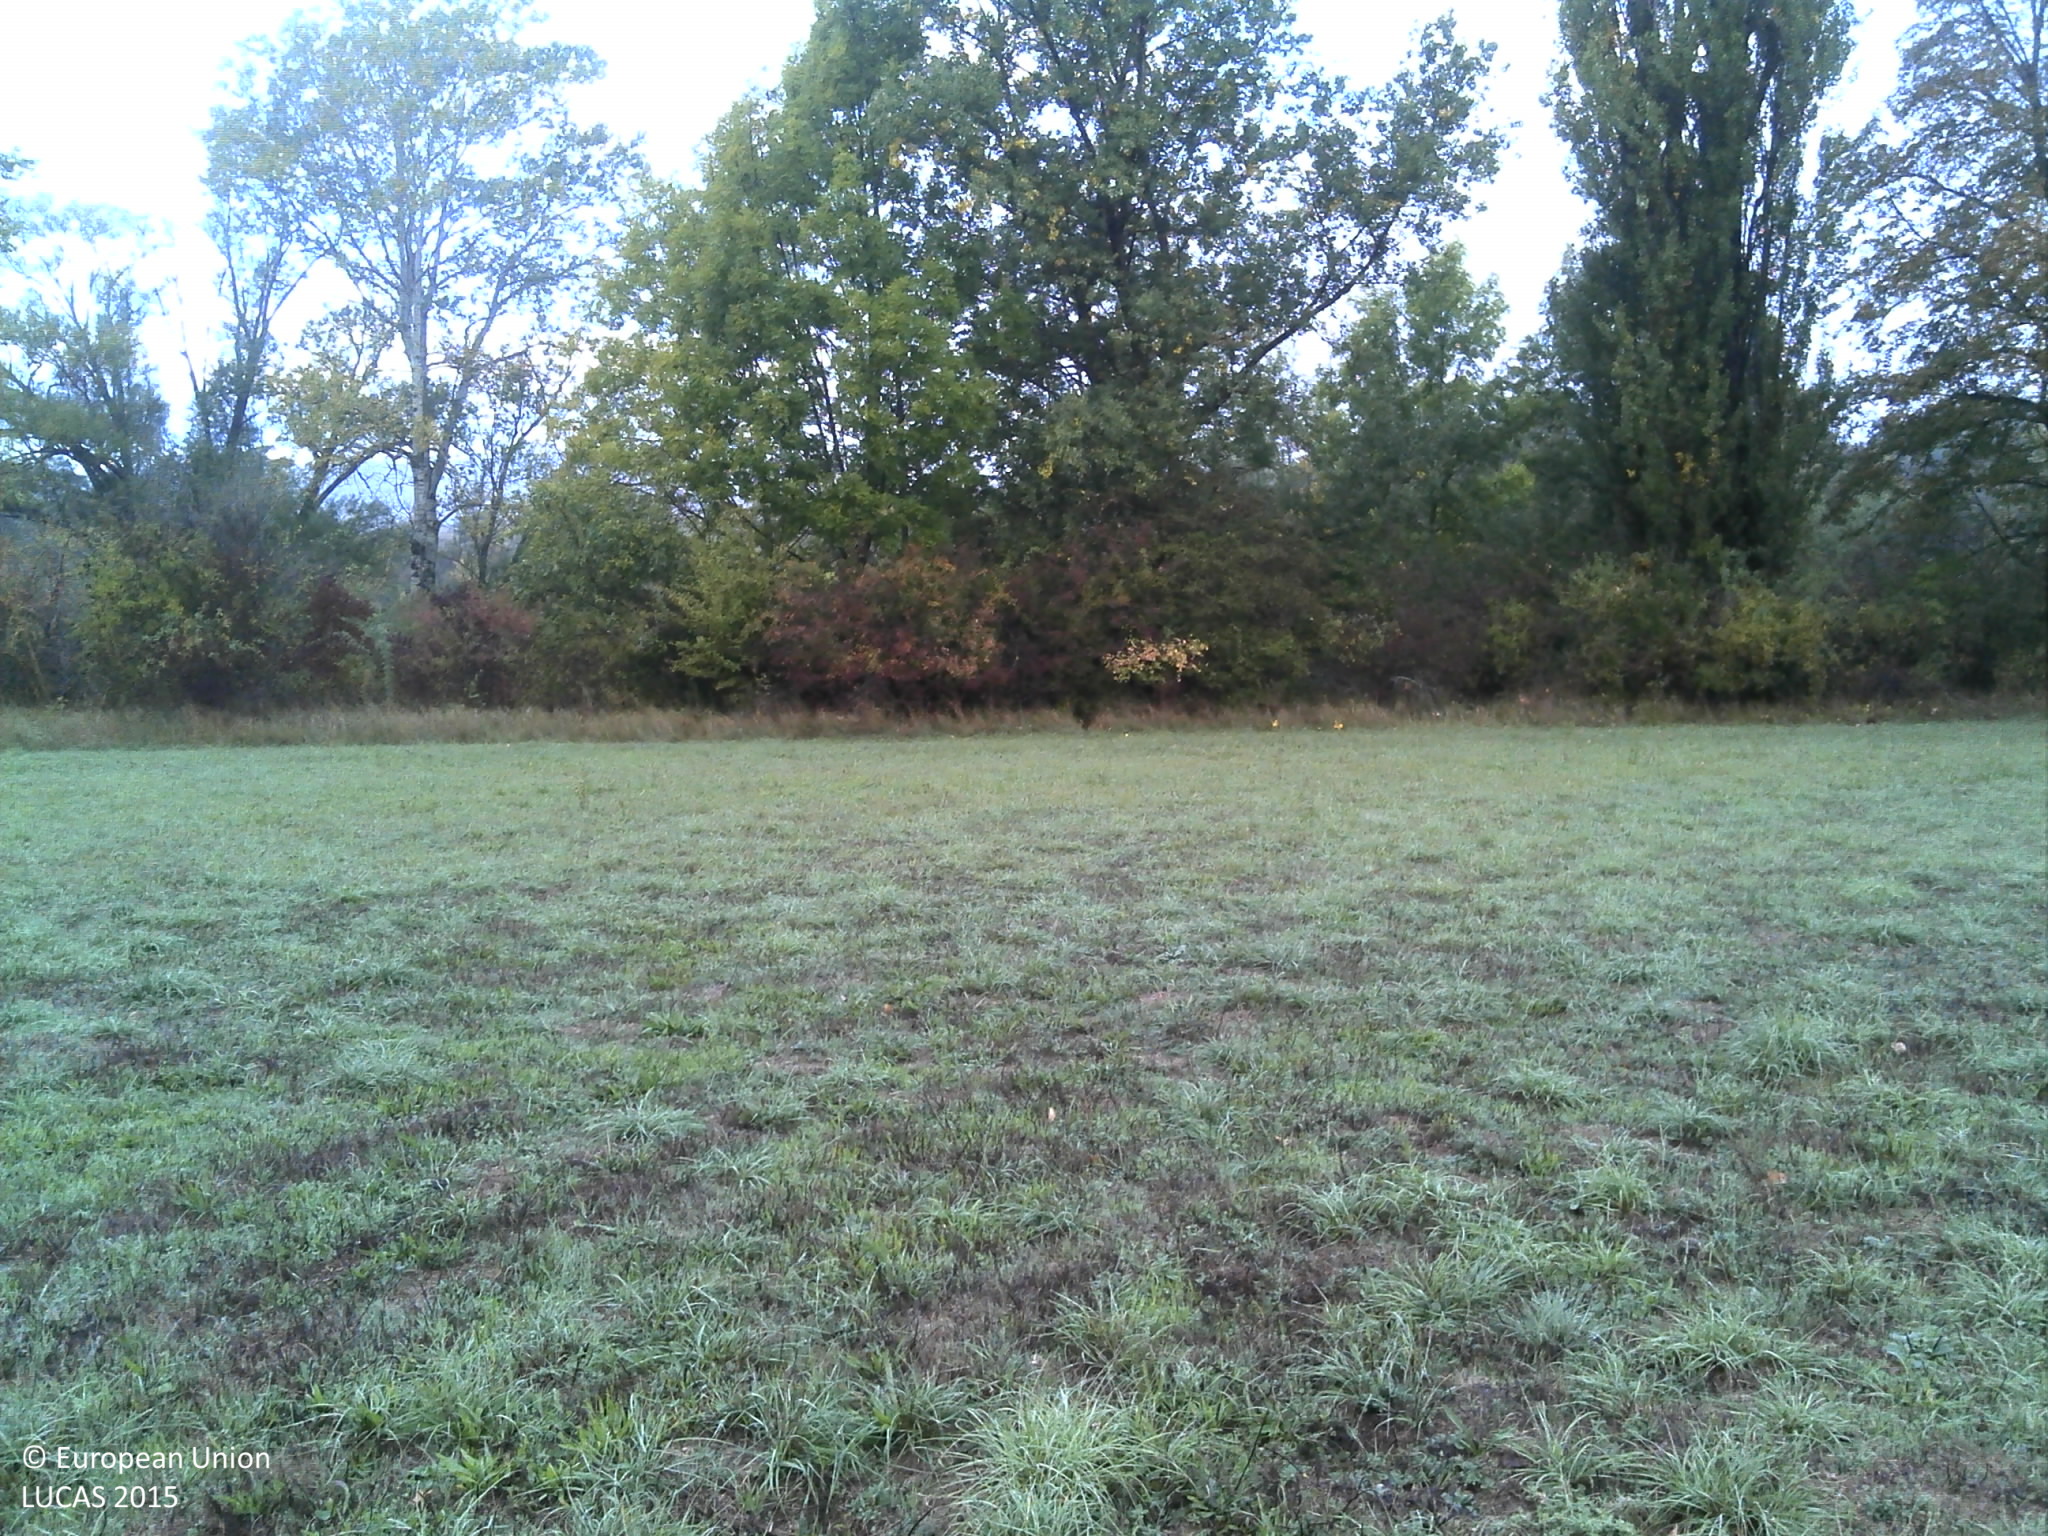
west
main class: Grassland
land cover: Grassland without tree/shrub cover
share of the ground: > 75 %
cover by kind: herbaceous plants 95 %, unconsolidated bare surface 5 %
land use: Agriculture (excluding fallow land and kitchen gardens)
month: September
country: FR
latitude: 43.7145
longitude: 6.5204
